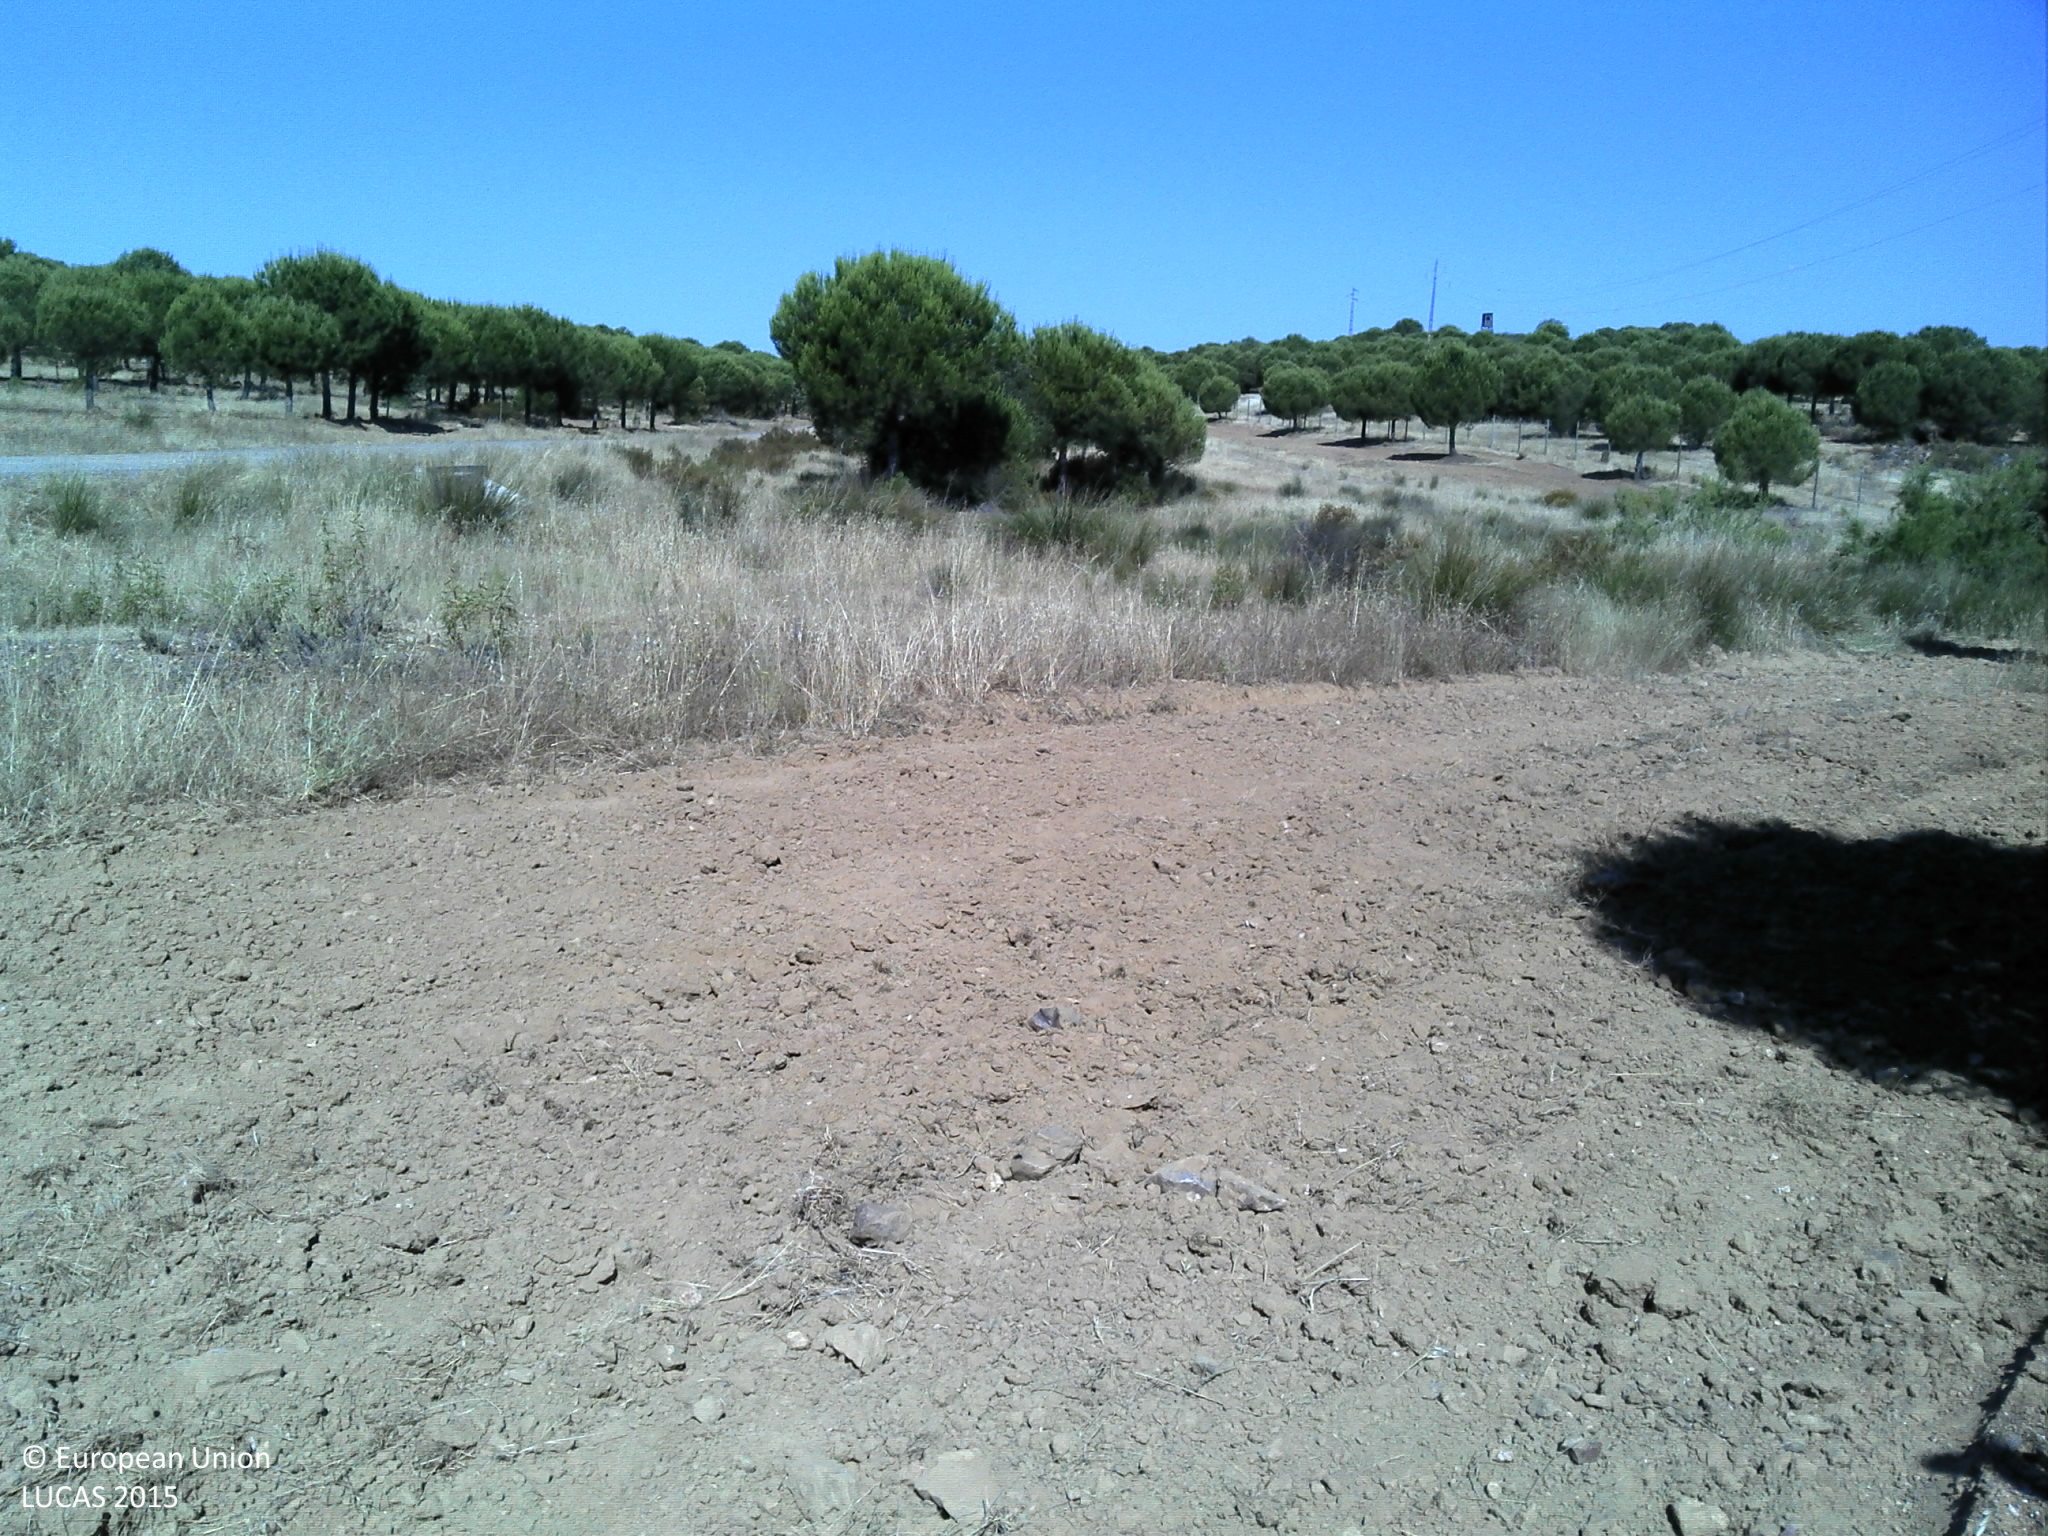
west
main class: Woodland
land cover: Pine dominated coniferous woodland
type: coniferous forest of the mediterranean region
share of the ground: 25 - 50 %
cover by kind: coniferous forest trees 75 %, herbaceous plants 25 %
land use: Forestry
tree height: < 5 m
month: June
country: PT
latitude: 37.6823
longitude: -7.6022
